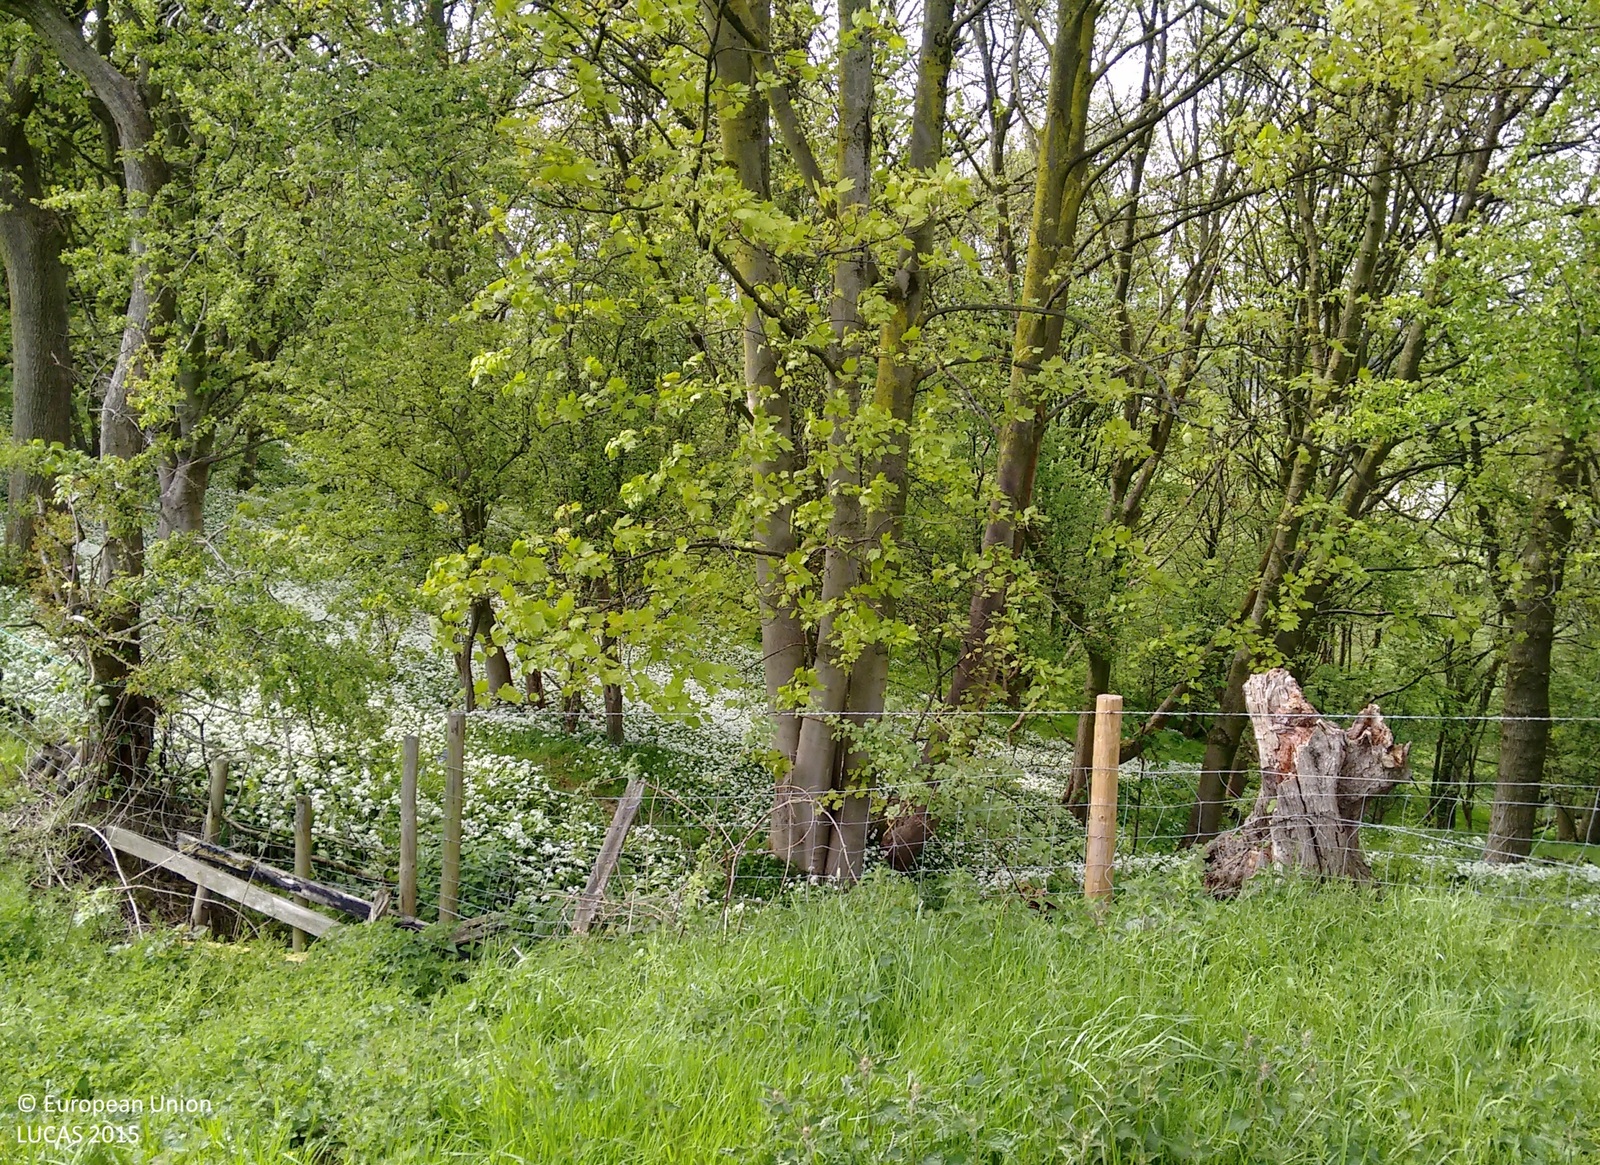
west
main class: Grassland
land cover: Grassland without tree/shrub cover
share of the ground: > 75 %
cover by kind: herbaceous plants 100 %
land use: Agriculture (excluding fallow land and kitchen gardens)
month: May
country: GB
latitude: 53.7559
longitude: -2.6409
